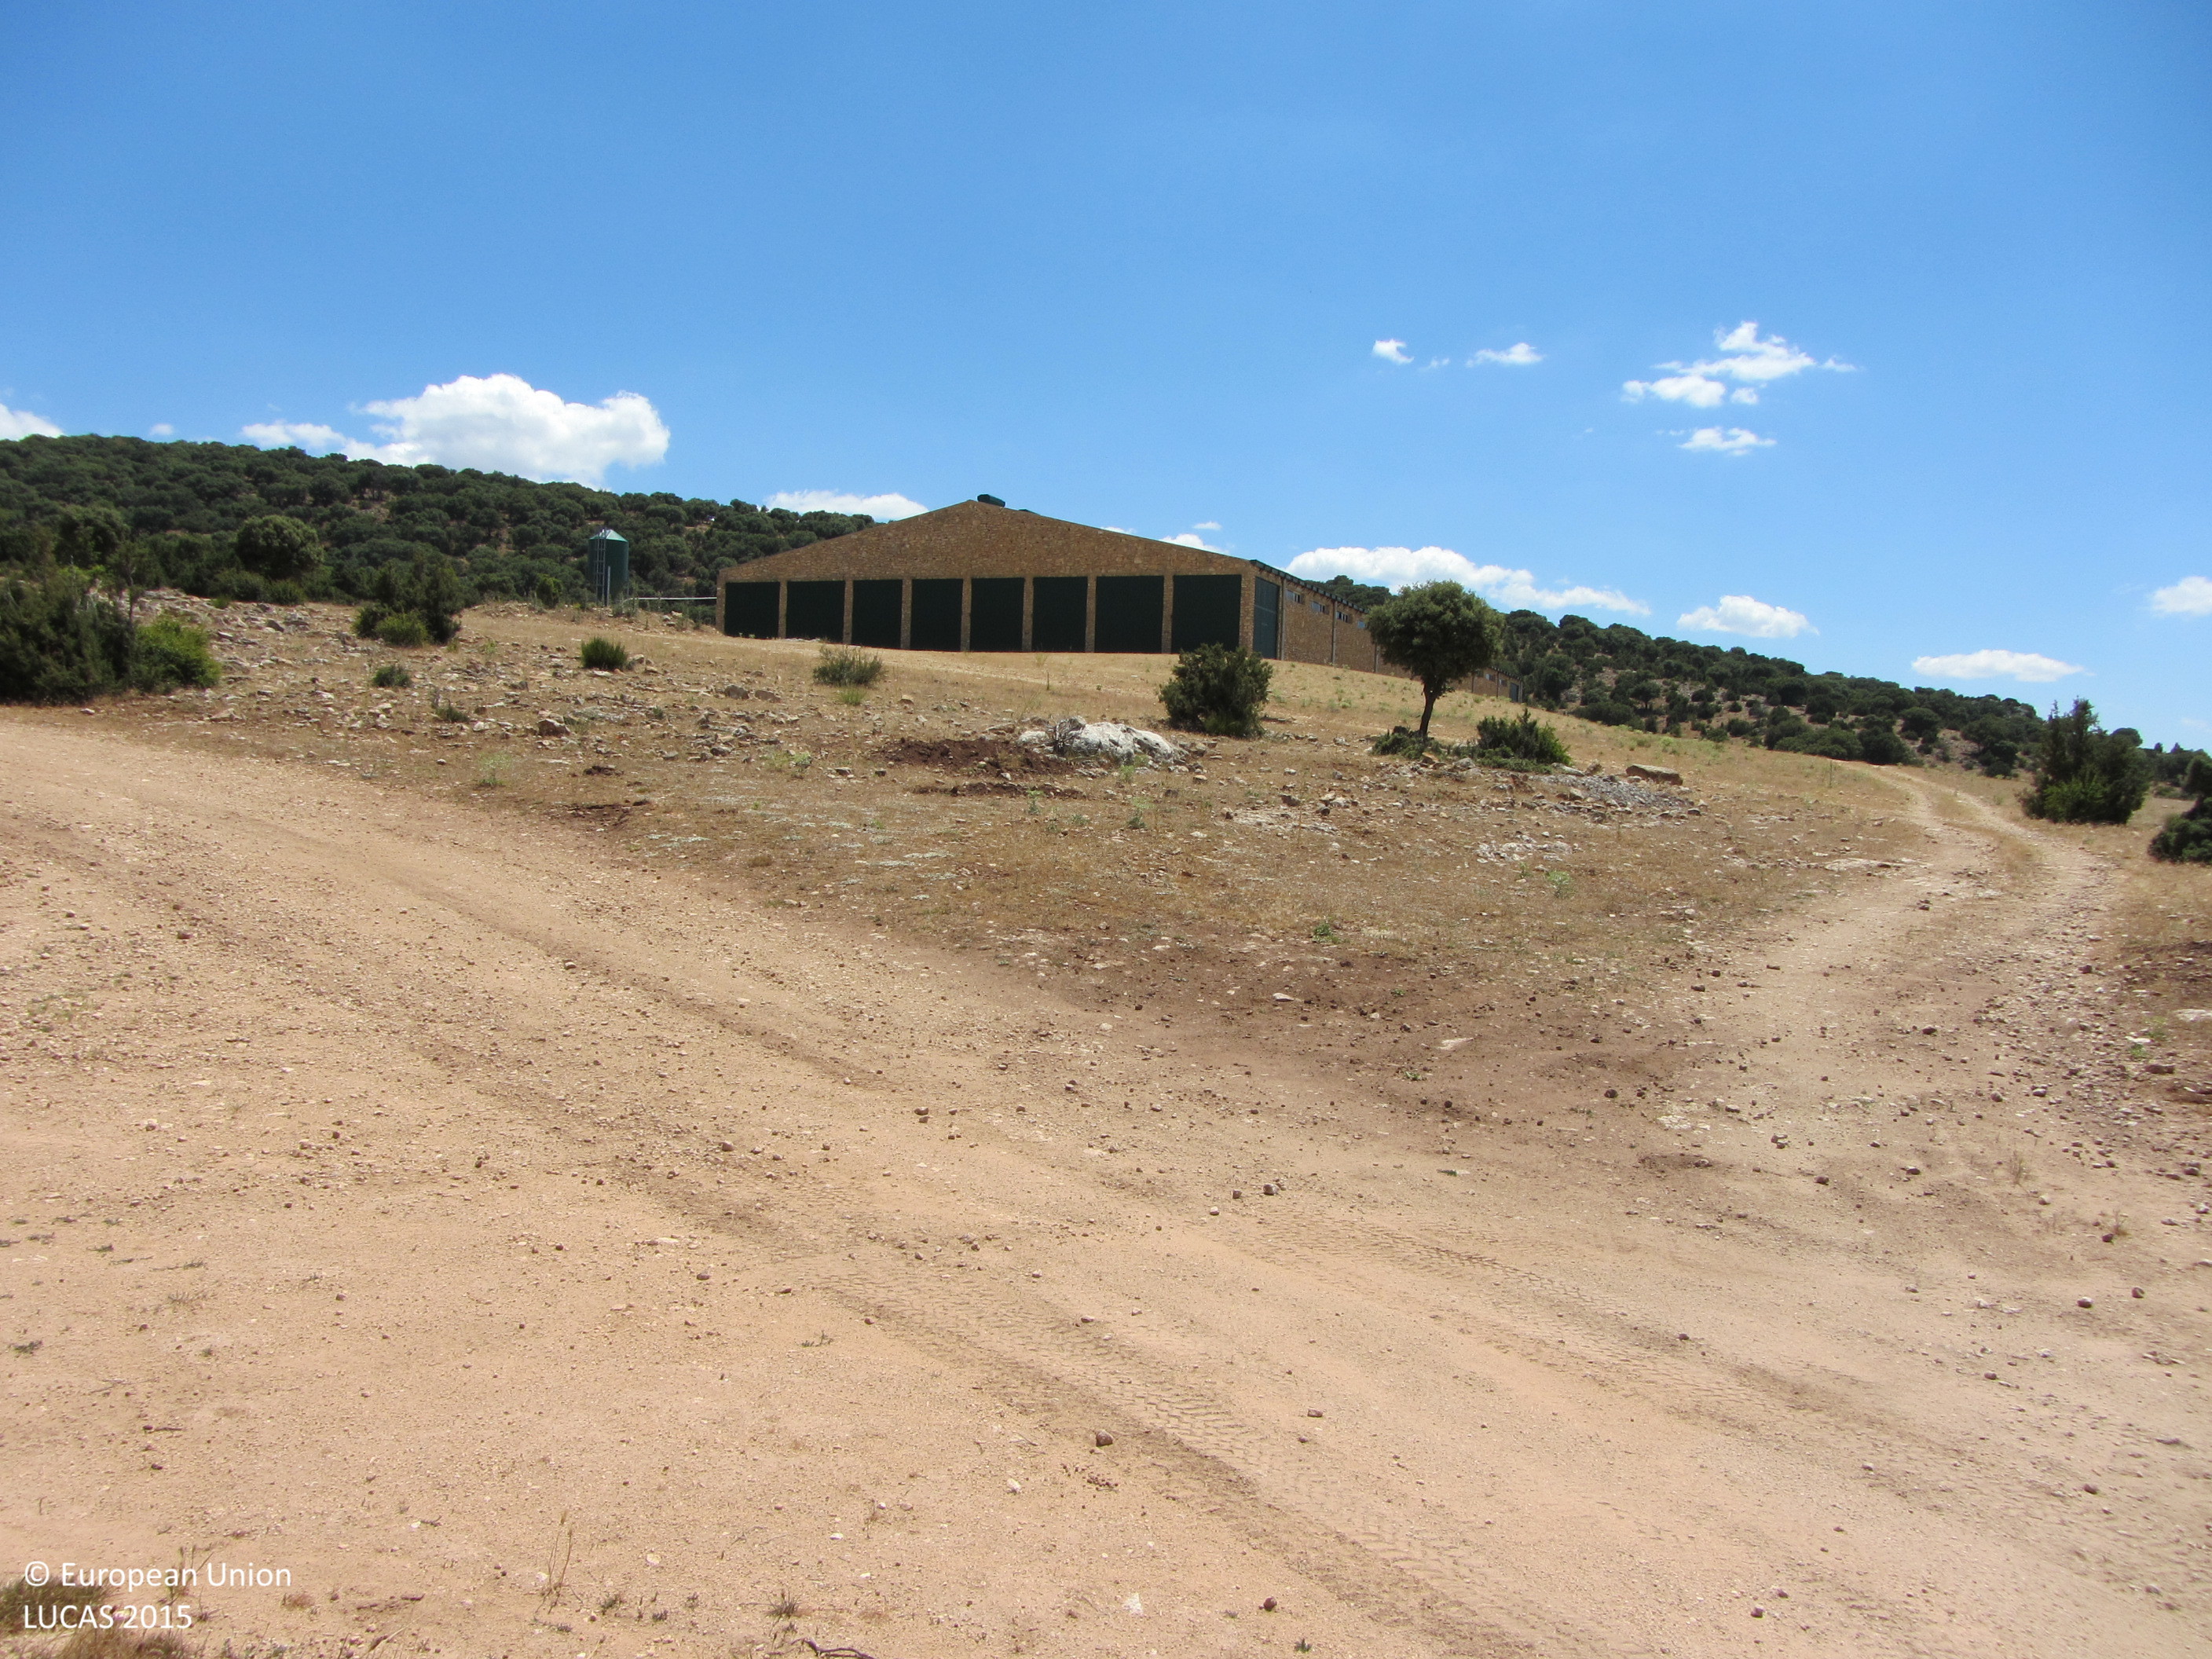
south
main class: Woodland
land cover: Broadleaved woodland
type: broadleaved evergreen forest
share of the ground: > 75 %
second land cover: Shrubland without tree cover
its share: 10 - 25 %
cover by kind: broadleaved forest trees 80 %, shrubs 10 %, consolidated bare surface 10 %
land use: Forestry
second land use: Agriculture (excluding fallow land and kitchen gardens)
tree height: > 5 m
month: June
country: ES
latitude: 38.1779
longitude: -2.4028
